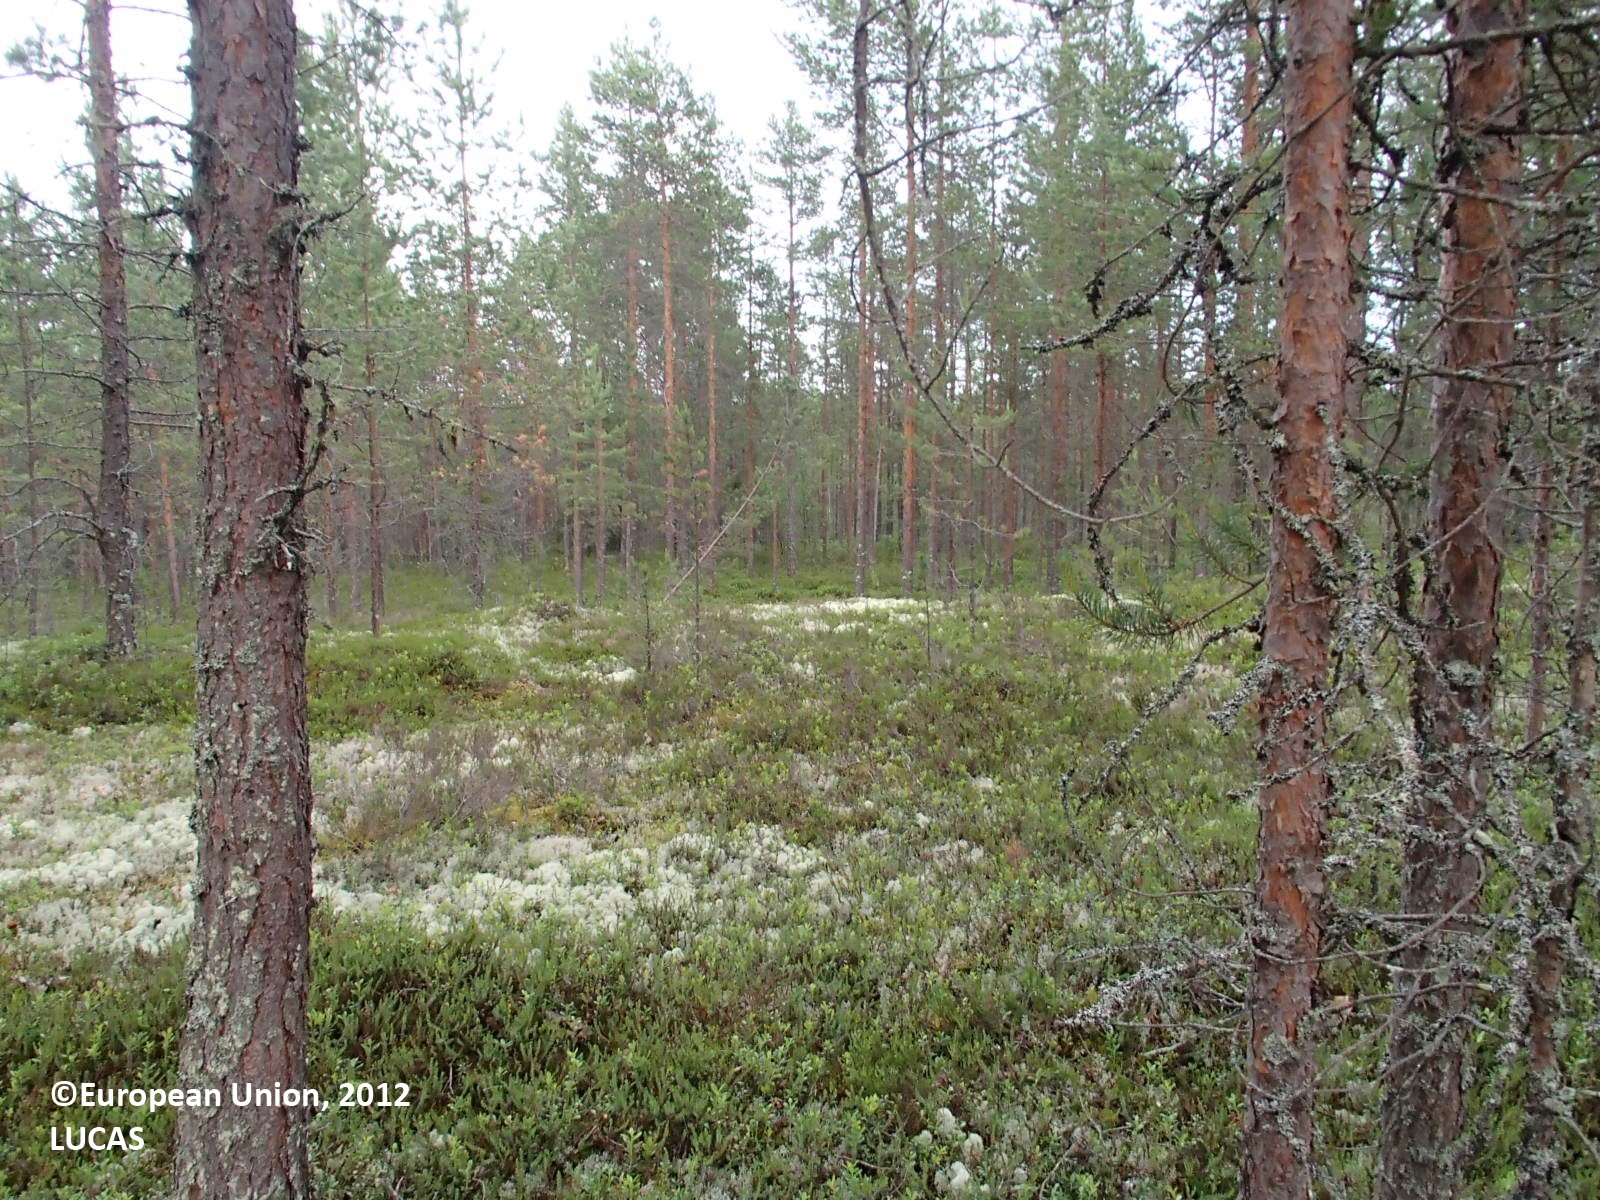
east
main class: Woodland
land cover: Pine dominated coniferous woodland
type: boreal forest
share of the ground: 50 - 75 %
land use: Forestry
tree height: > 5 m
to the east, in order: Pine dominated coniferous woodland; Ditches and canals; Pine dominated coniferous woodland; Ditches and canals; Pine dominated mixed woodland; Pine dominated coniferous woodland; Ditches and canals; Pine dominated coniferous woodland; Ditches and canals; Pine dominated coniferous woodland; Ditches and canals; Grassland with sparse tree/shrub cover
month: July
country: FI
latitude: 64.3241
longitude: 26.3086
